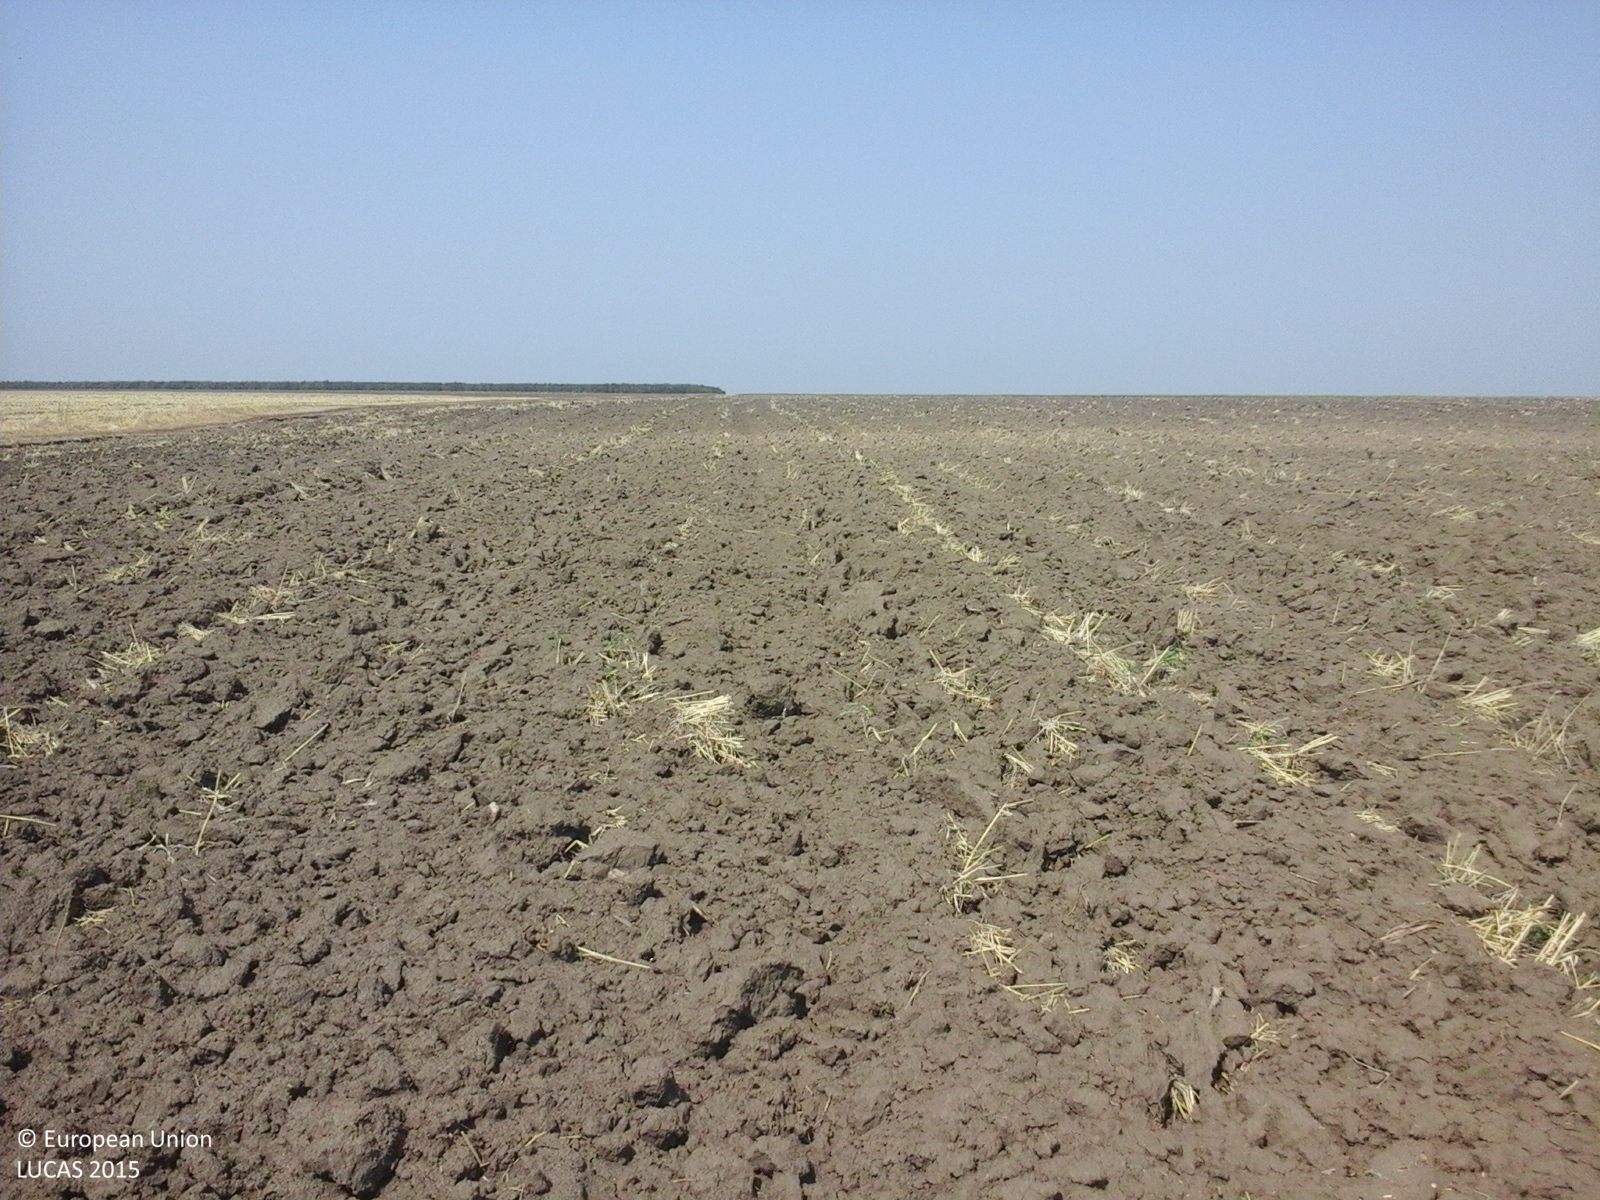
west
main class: Cropland
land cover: Common wheat
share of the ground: < 10 %
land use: Agriculture (excluding fallow land and kitchen gardens)
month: July
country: RO
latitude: 45.6907
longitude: 27.6892
